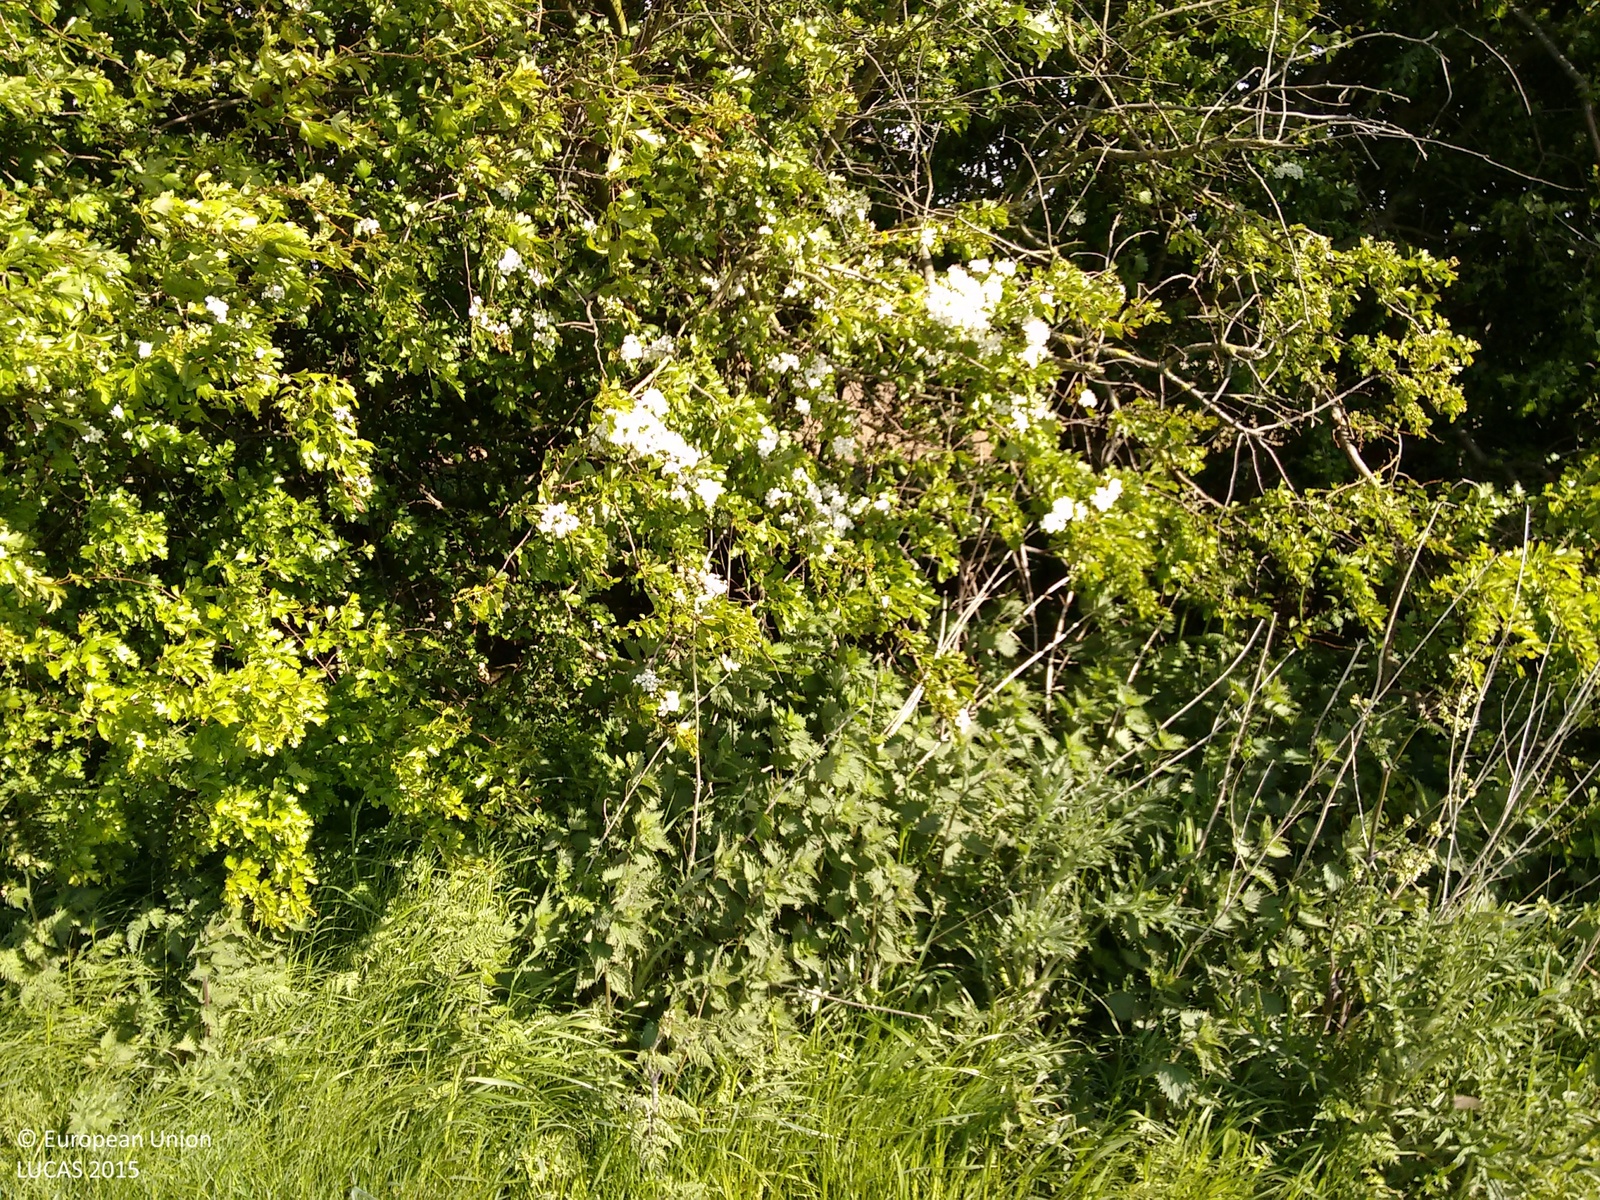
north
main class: Grassland
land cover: Grassland without tree/shrub cover
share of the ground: > 75 %
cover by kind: herbaceous plants 100 %
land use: Agriculture (excluding fallow land and kitchen gardens)
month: May
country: GB
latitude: 53.5894
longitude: -1.5779
